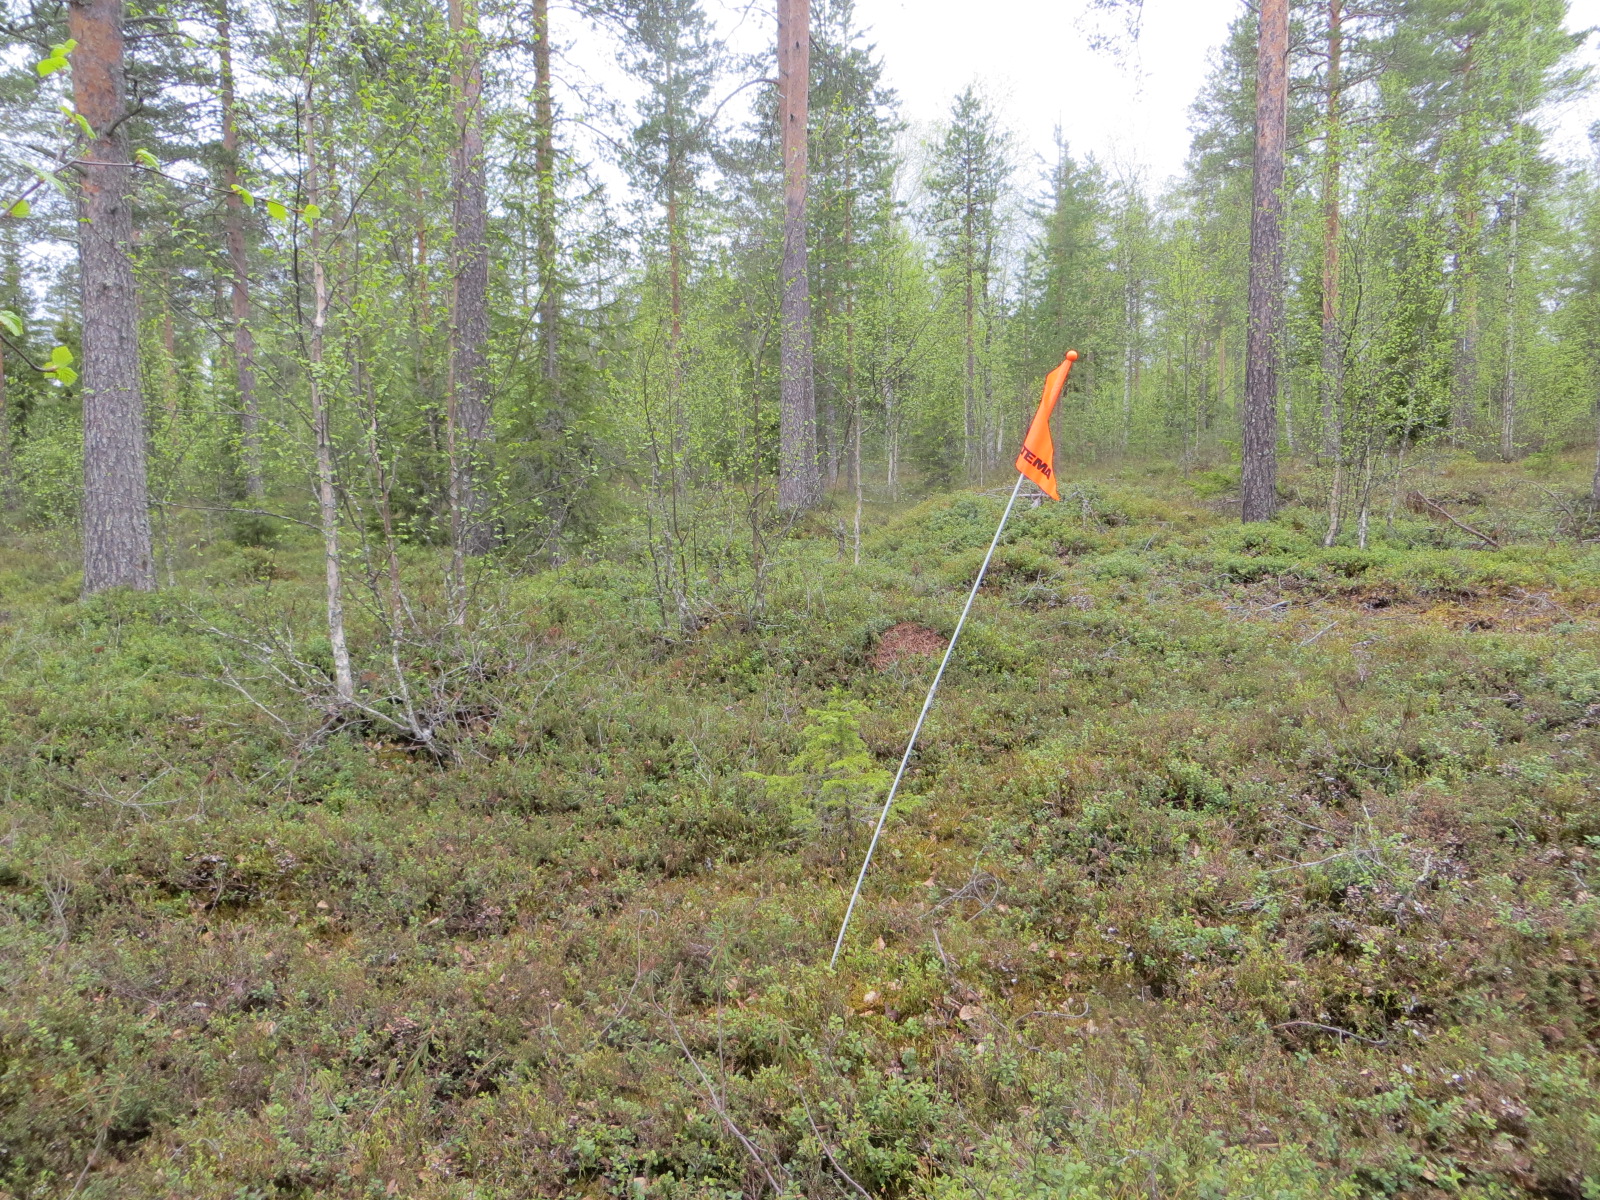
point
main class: Woodland
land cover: Pine dominated mixed woodland
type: boreal forest
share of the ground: 50 - 75 %
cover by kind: coniferous forest trees 35 %, broadleaved forest trees 35 %, shrubs 25 %, lichens and mosses 5 %
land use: Forestry
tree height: > 5 m
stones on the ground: < 10 %
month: June
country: FI
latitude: 66.5447
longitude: 25.8075
